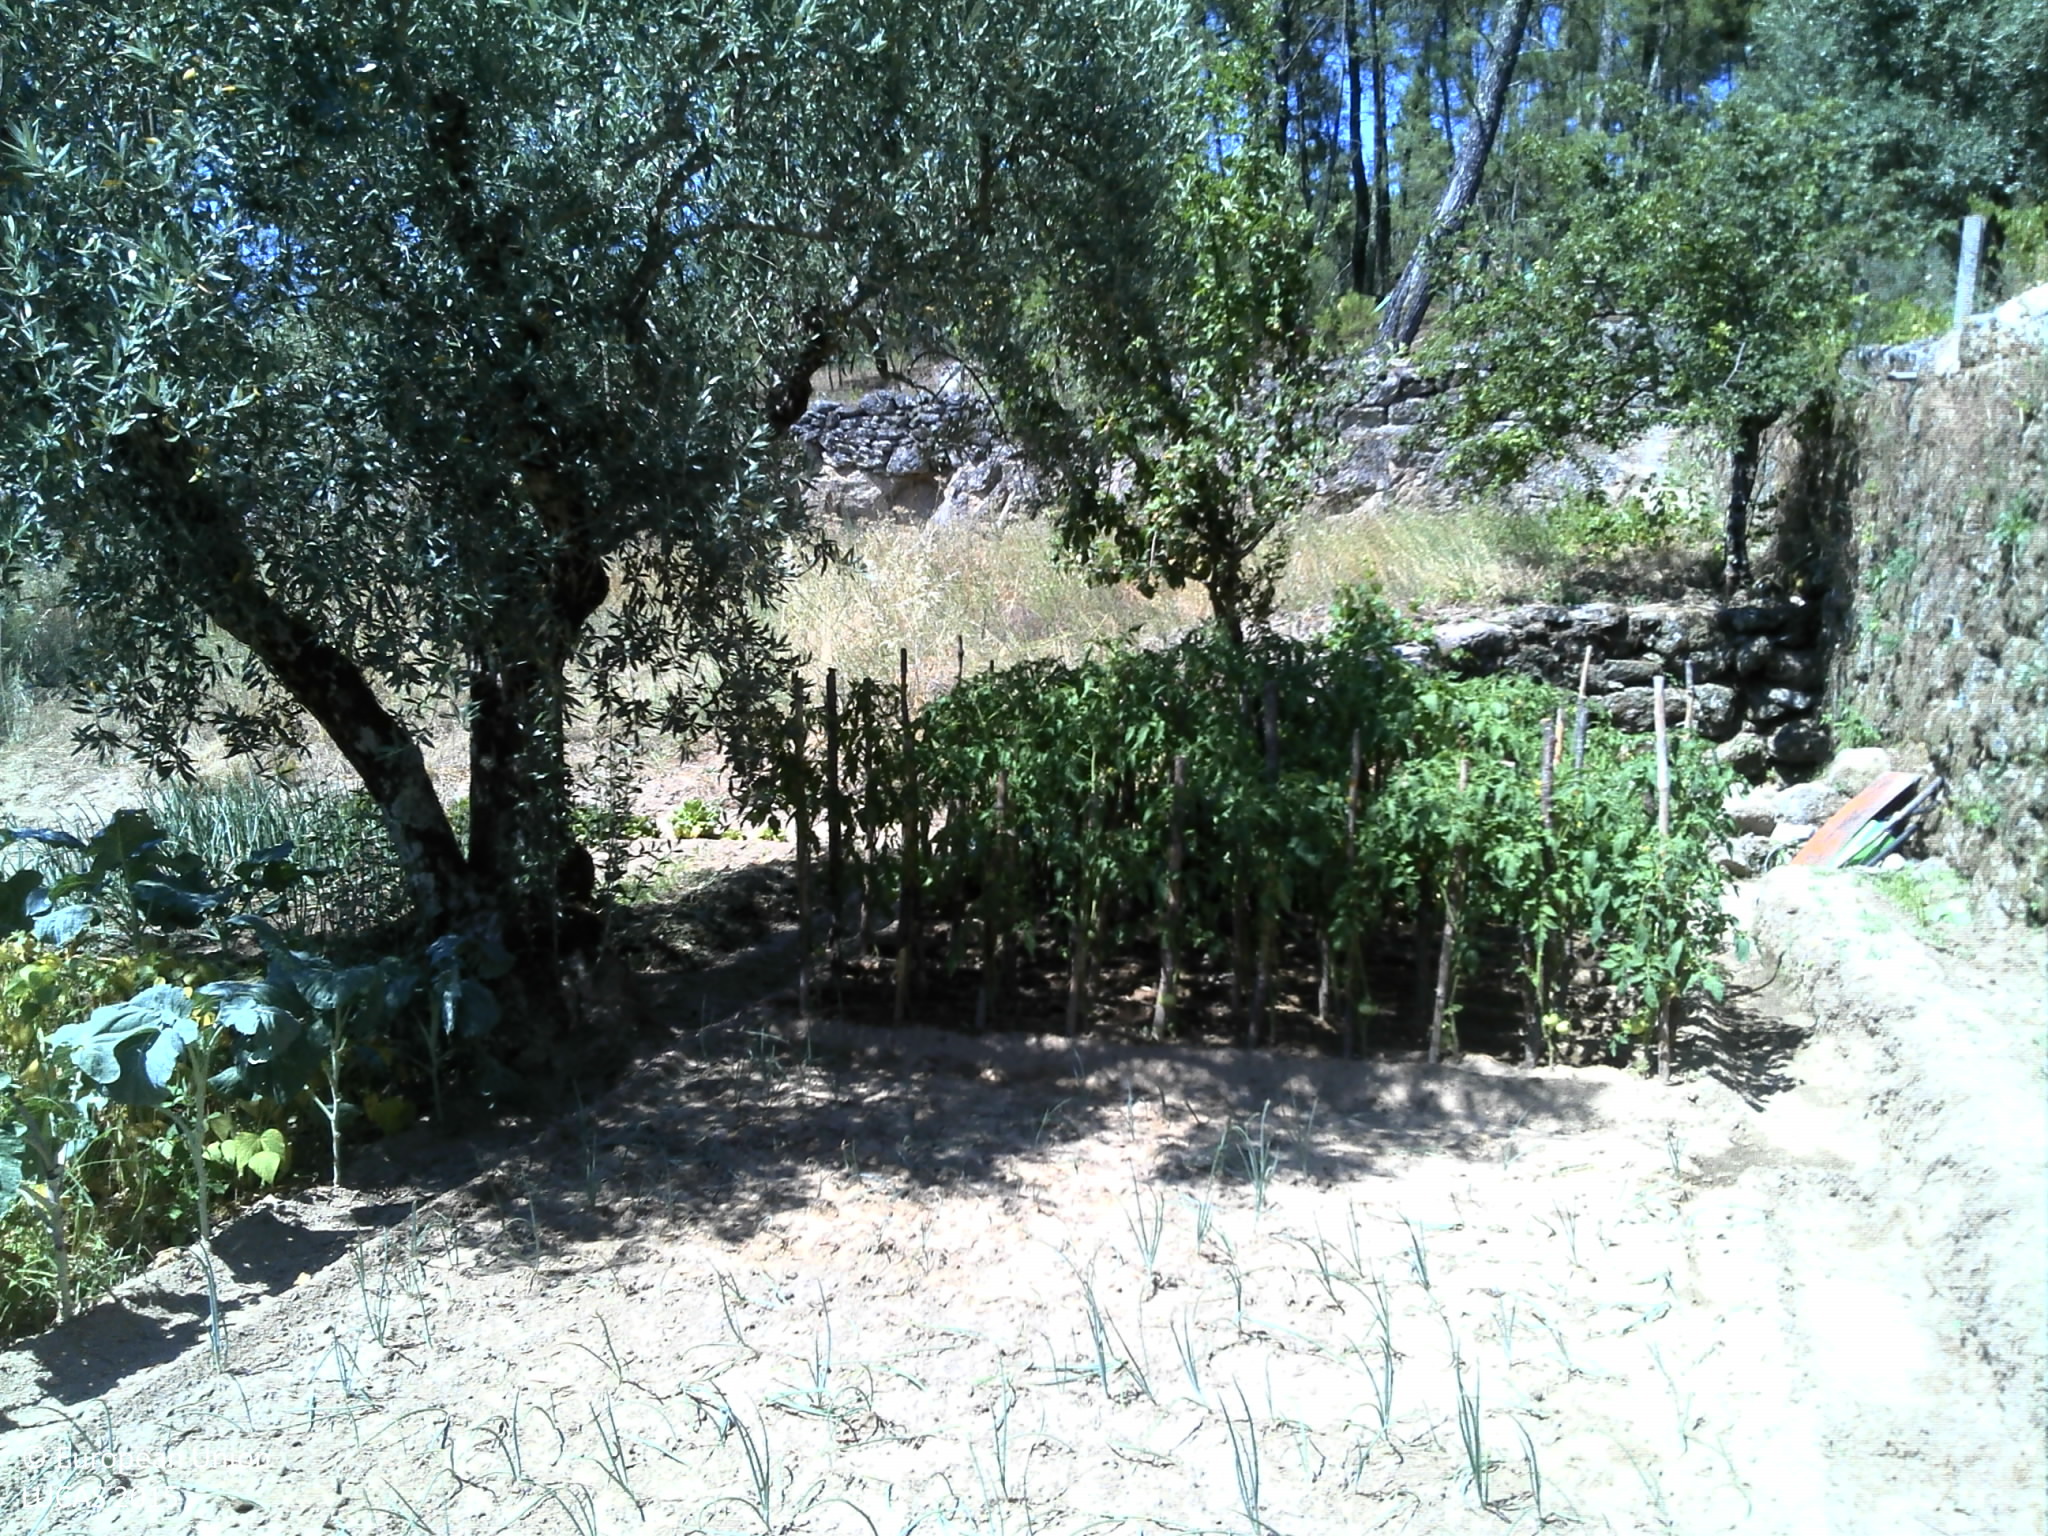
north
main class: Cropland
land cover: Olive groves
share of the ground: 10 - 25 %
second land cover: Other fresh vegetables
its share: 25 - 50 %
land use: Agriculture (excluding fallow land and kitchen gardens)
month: July
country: PT
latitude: 40.7369
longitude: -7.5590
